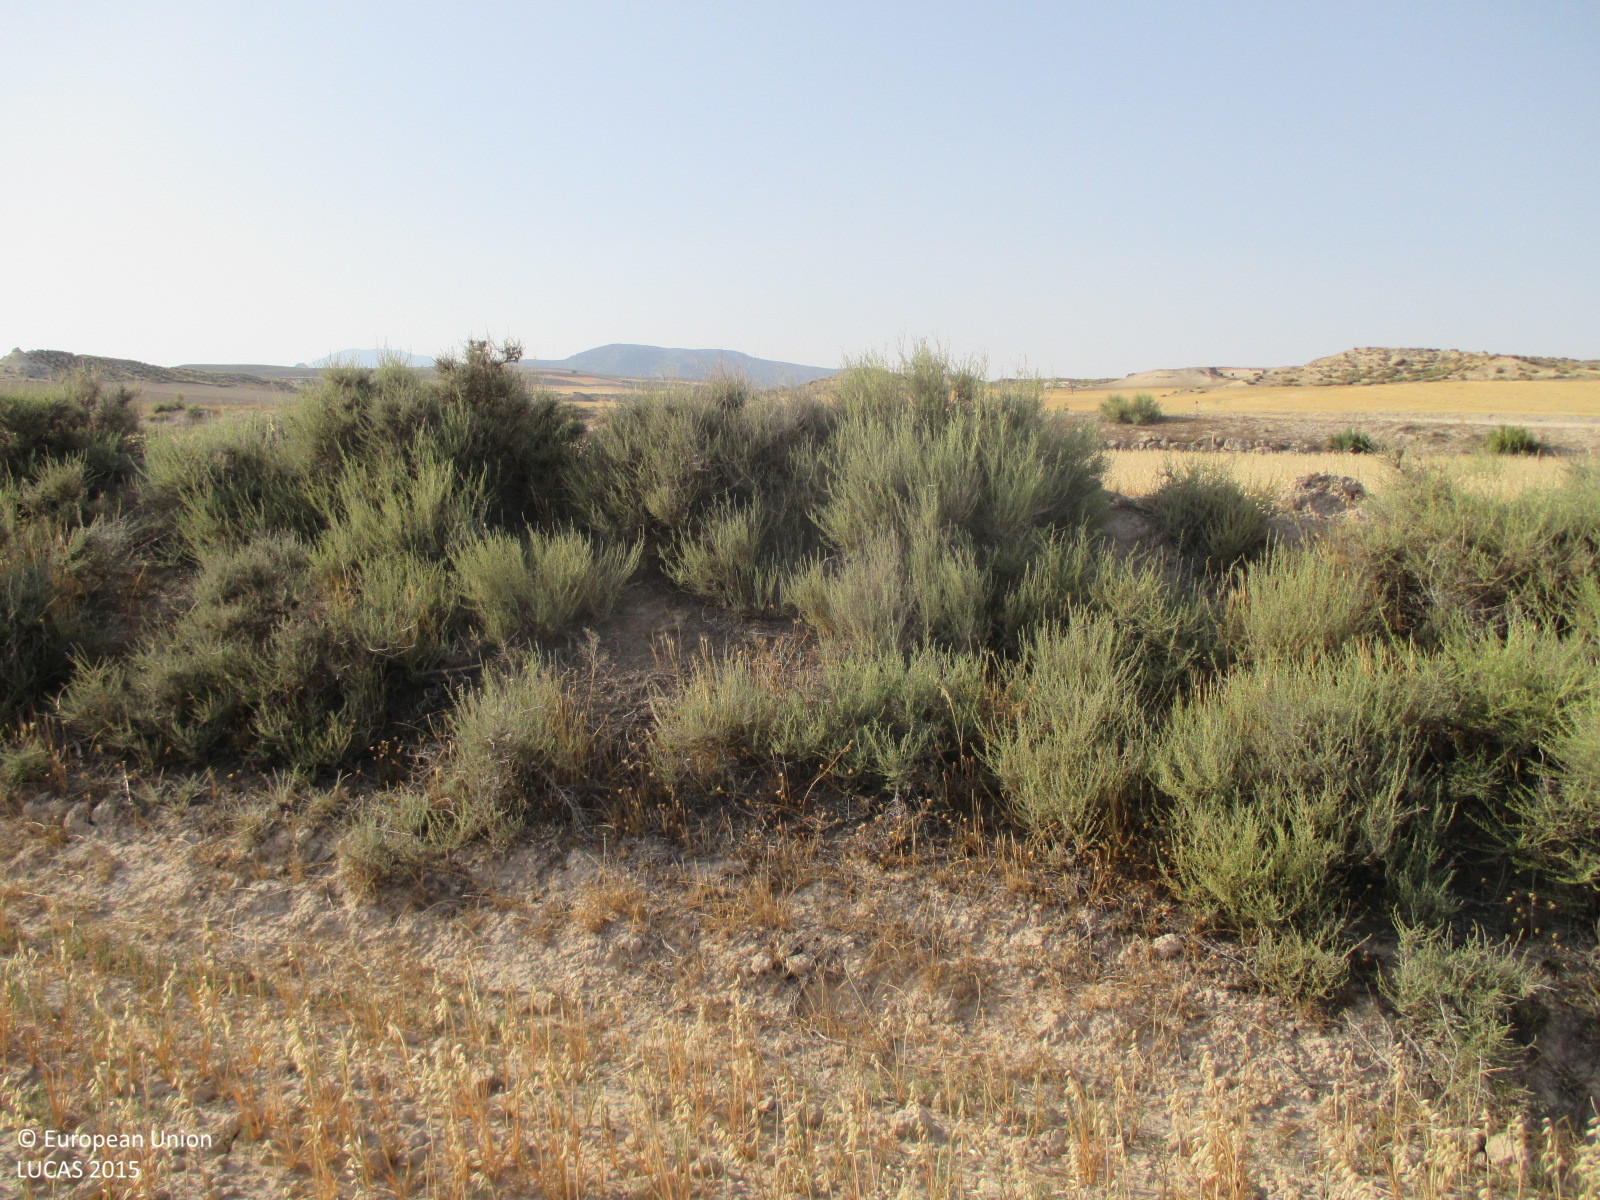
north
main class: Cropland
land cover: Oats
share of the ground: 25 - 50 %
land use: Agriculture (excluding fallow land and kitchen gardens)
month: June
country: ES
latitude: 37.7669
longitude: -2.4647
